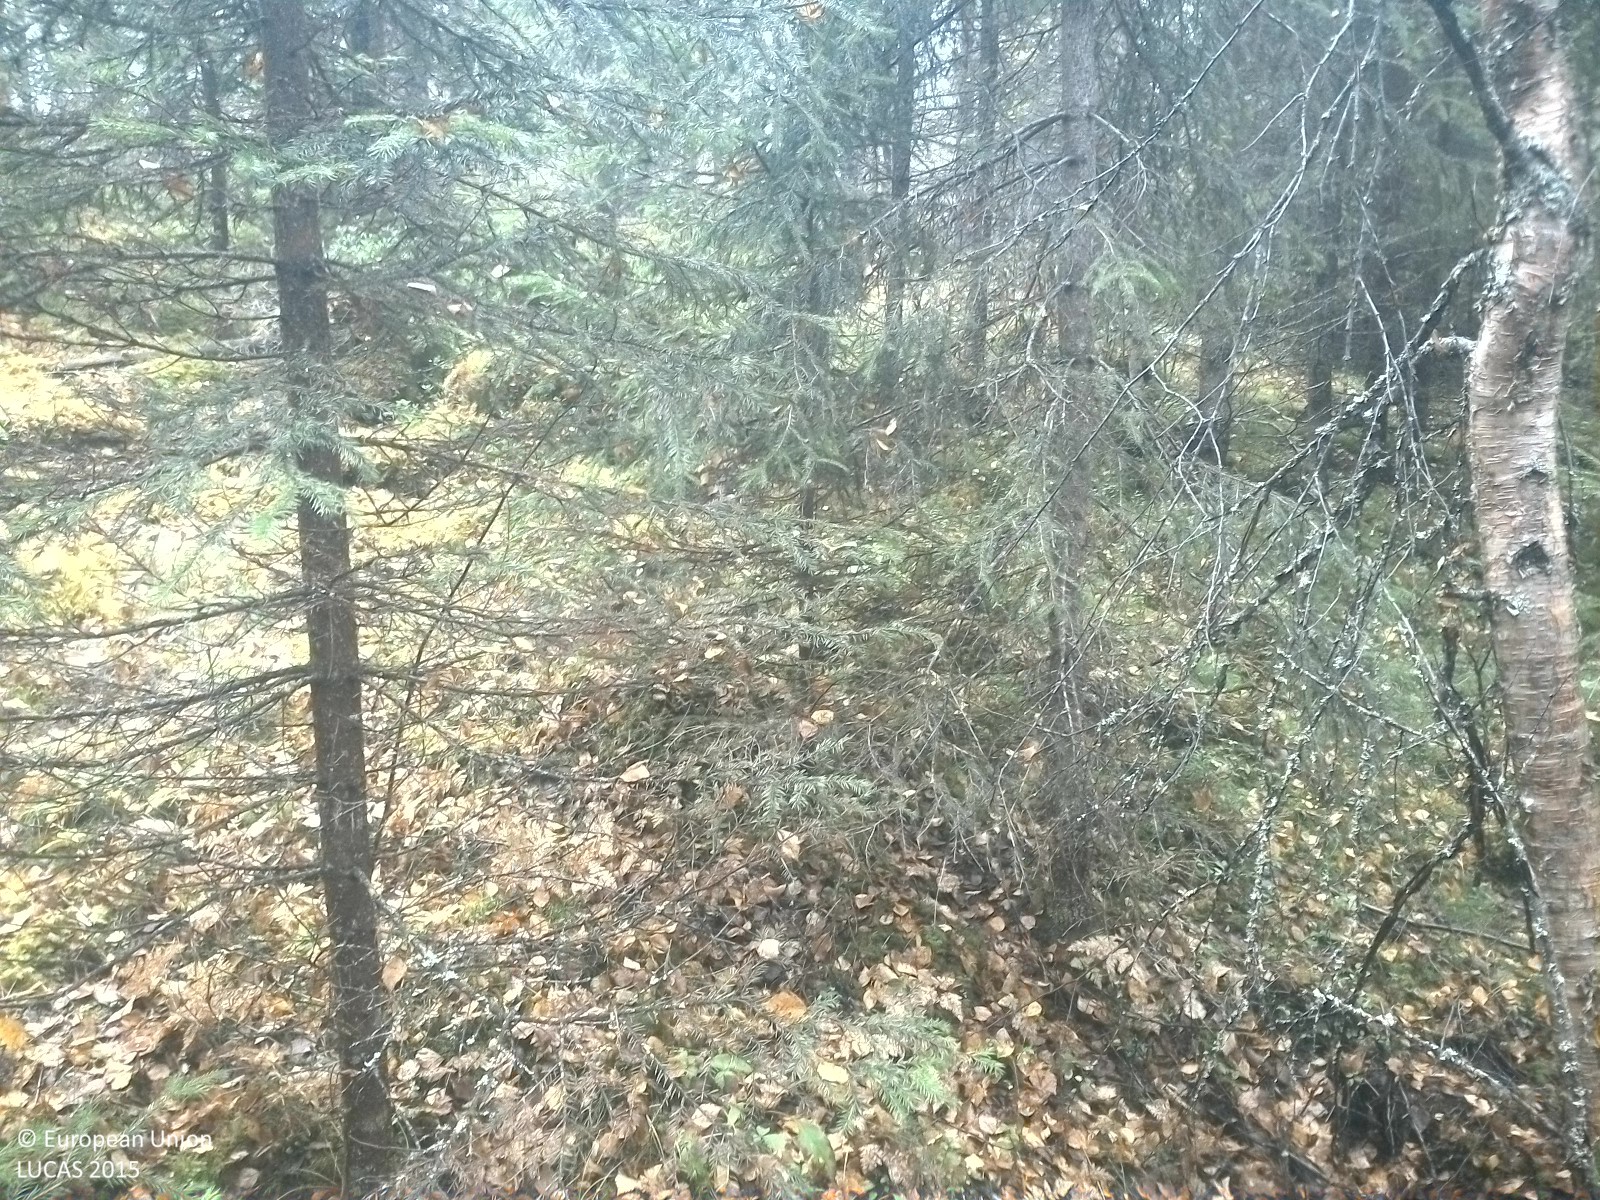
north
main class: Woodland
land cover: Spruce dominated mixed woodland
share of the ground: 50 - 75 %
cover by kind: coniferous forest trees 45 %, broadleaved forest trees 25 %, herbaceous plants 15 %, lichens and mosses 15 %
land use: Forestry
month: September
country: SE
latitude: 62.1825
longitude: 15.6092
